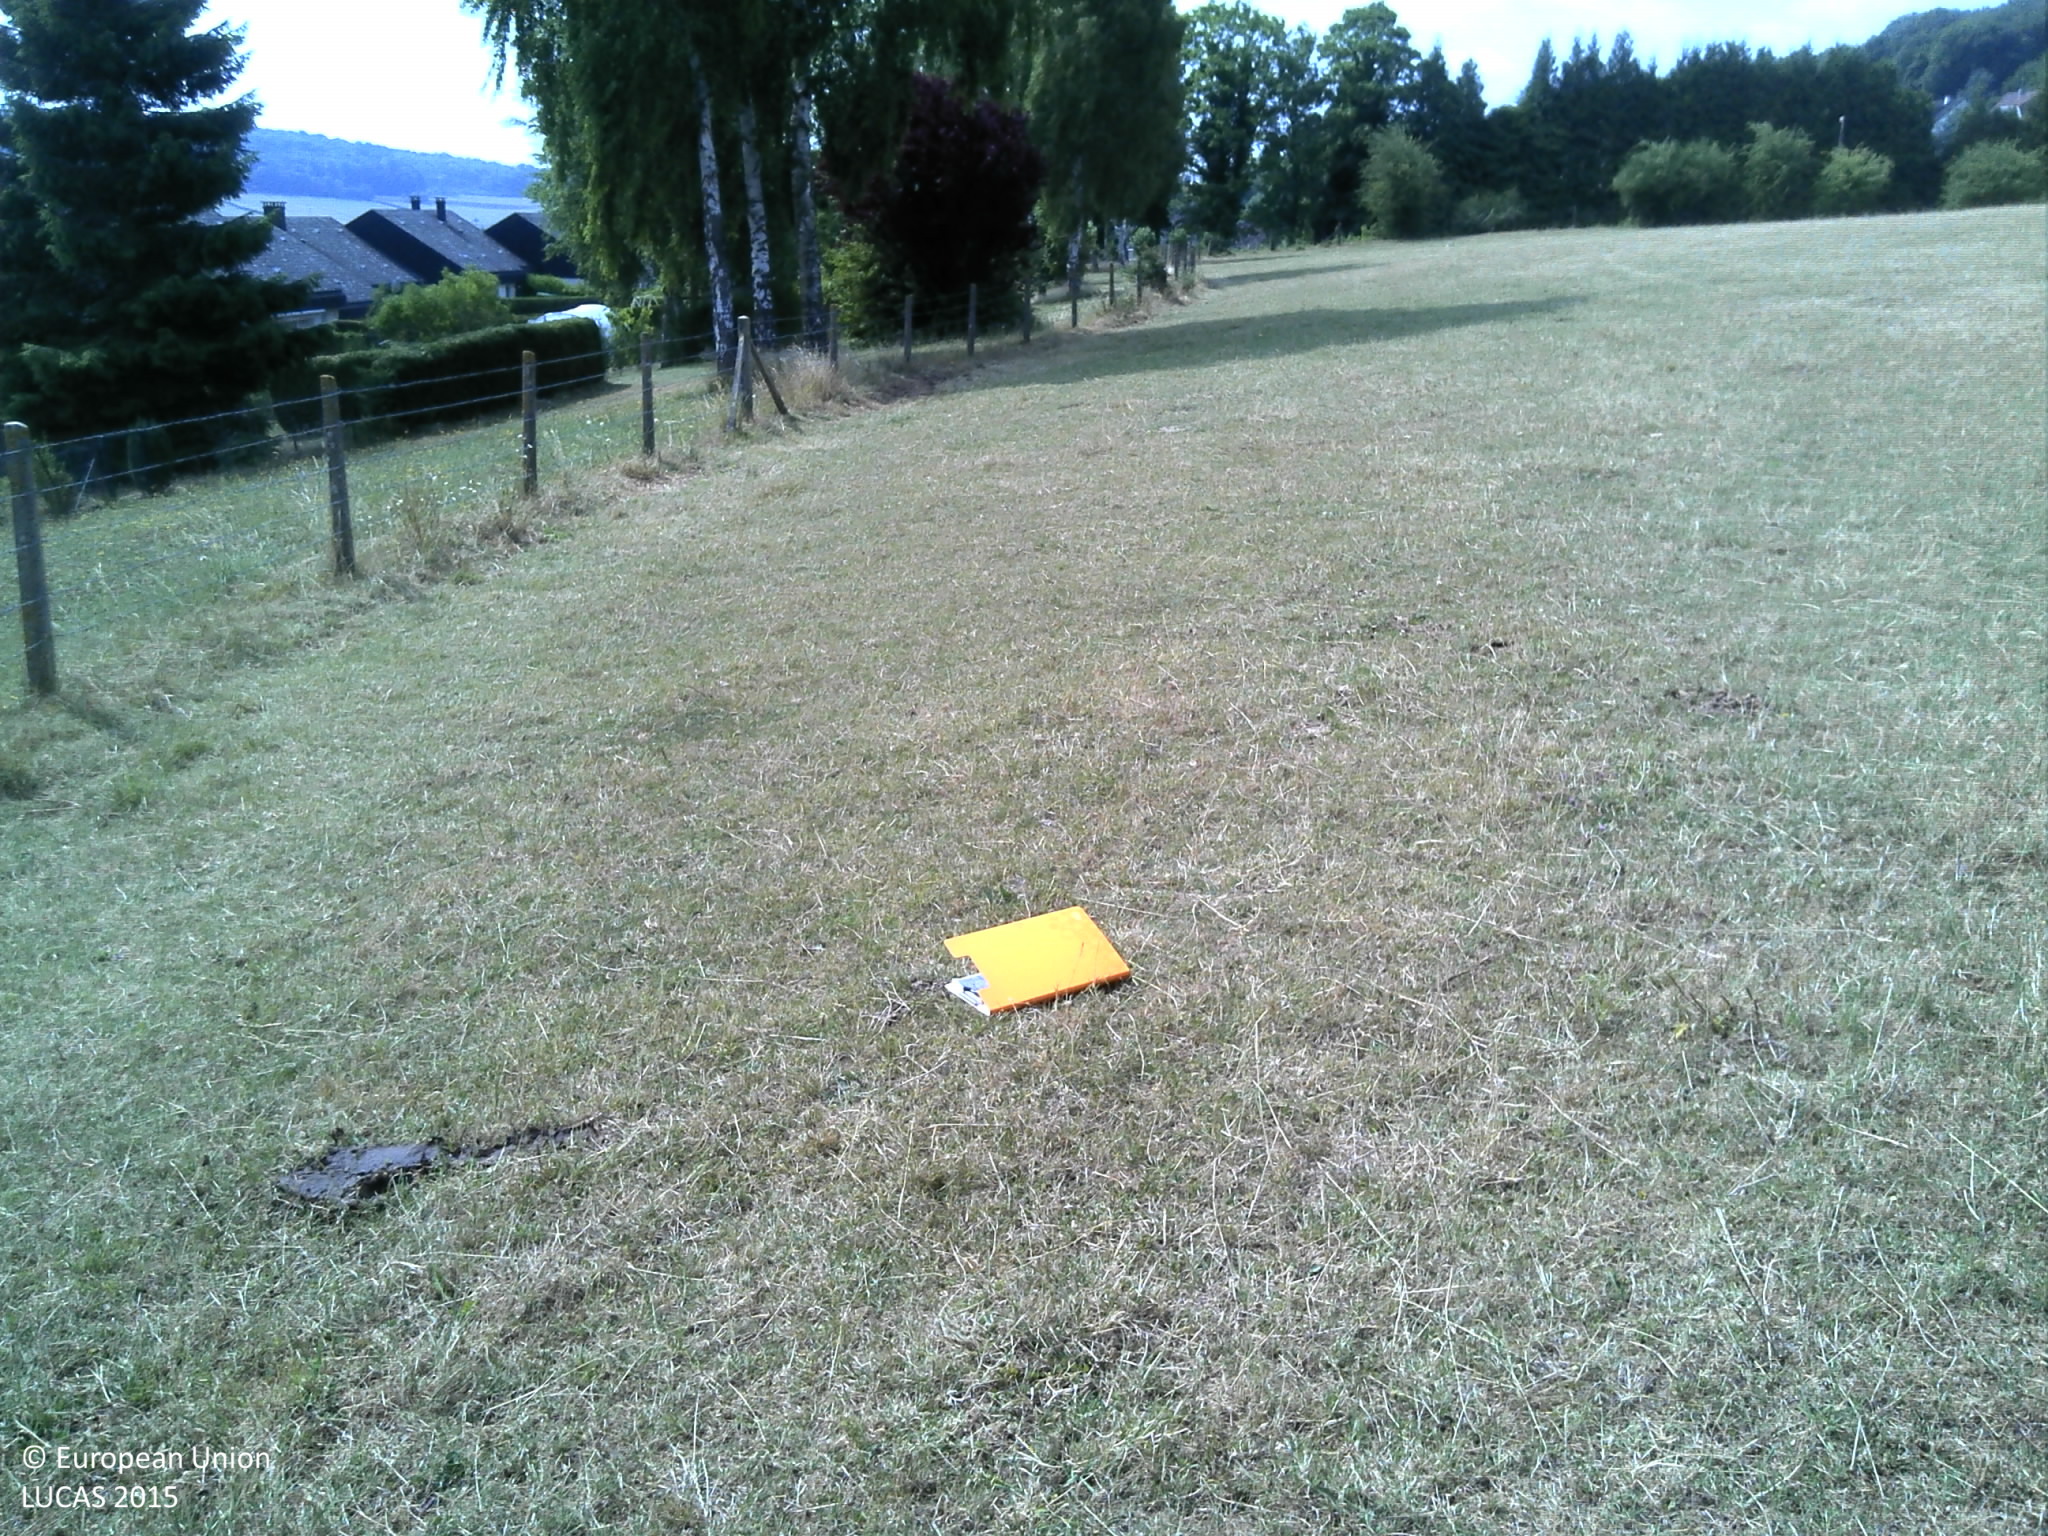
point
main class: Grassland
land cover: Grassland without tree/shrub cover
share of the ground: > 75 %
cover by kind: herbaceous plants 100 %
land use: Agriculture (excluding fallow land and kitchen gardens)
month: July
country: FR
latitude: 49.7763
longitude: 1.7483
